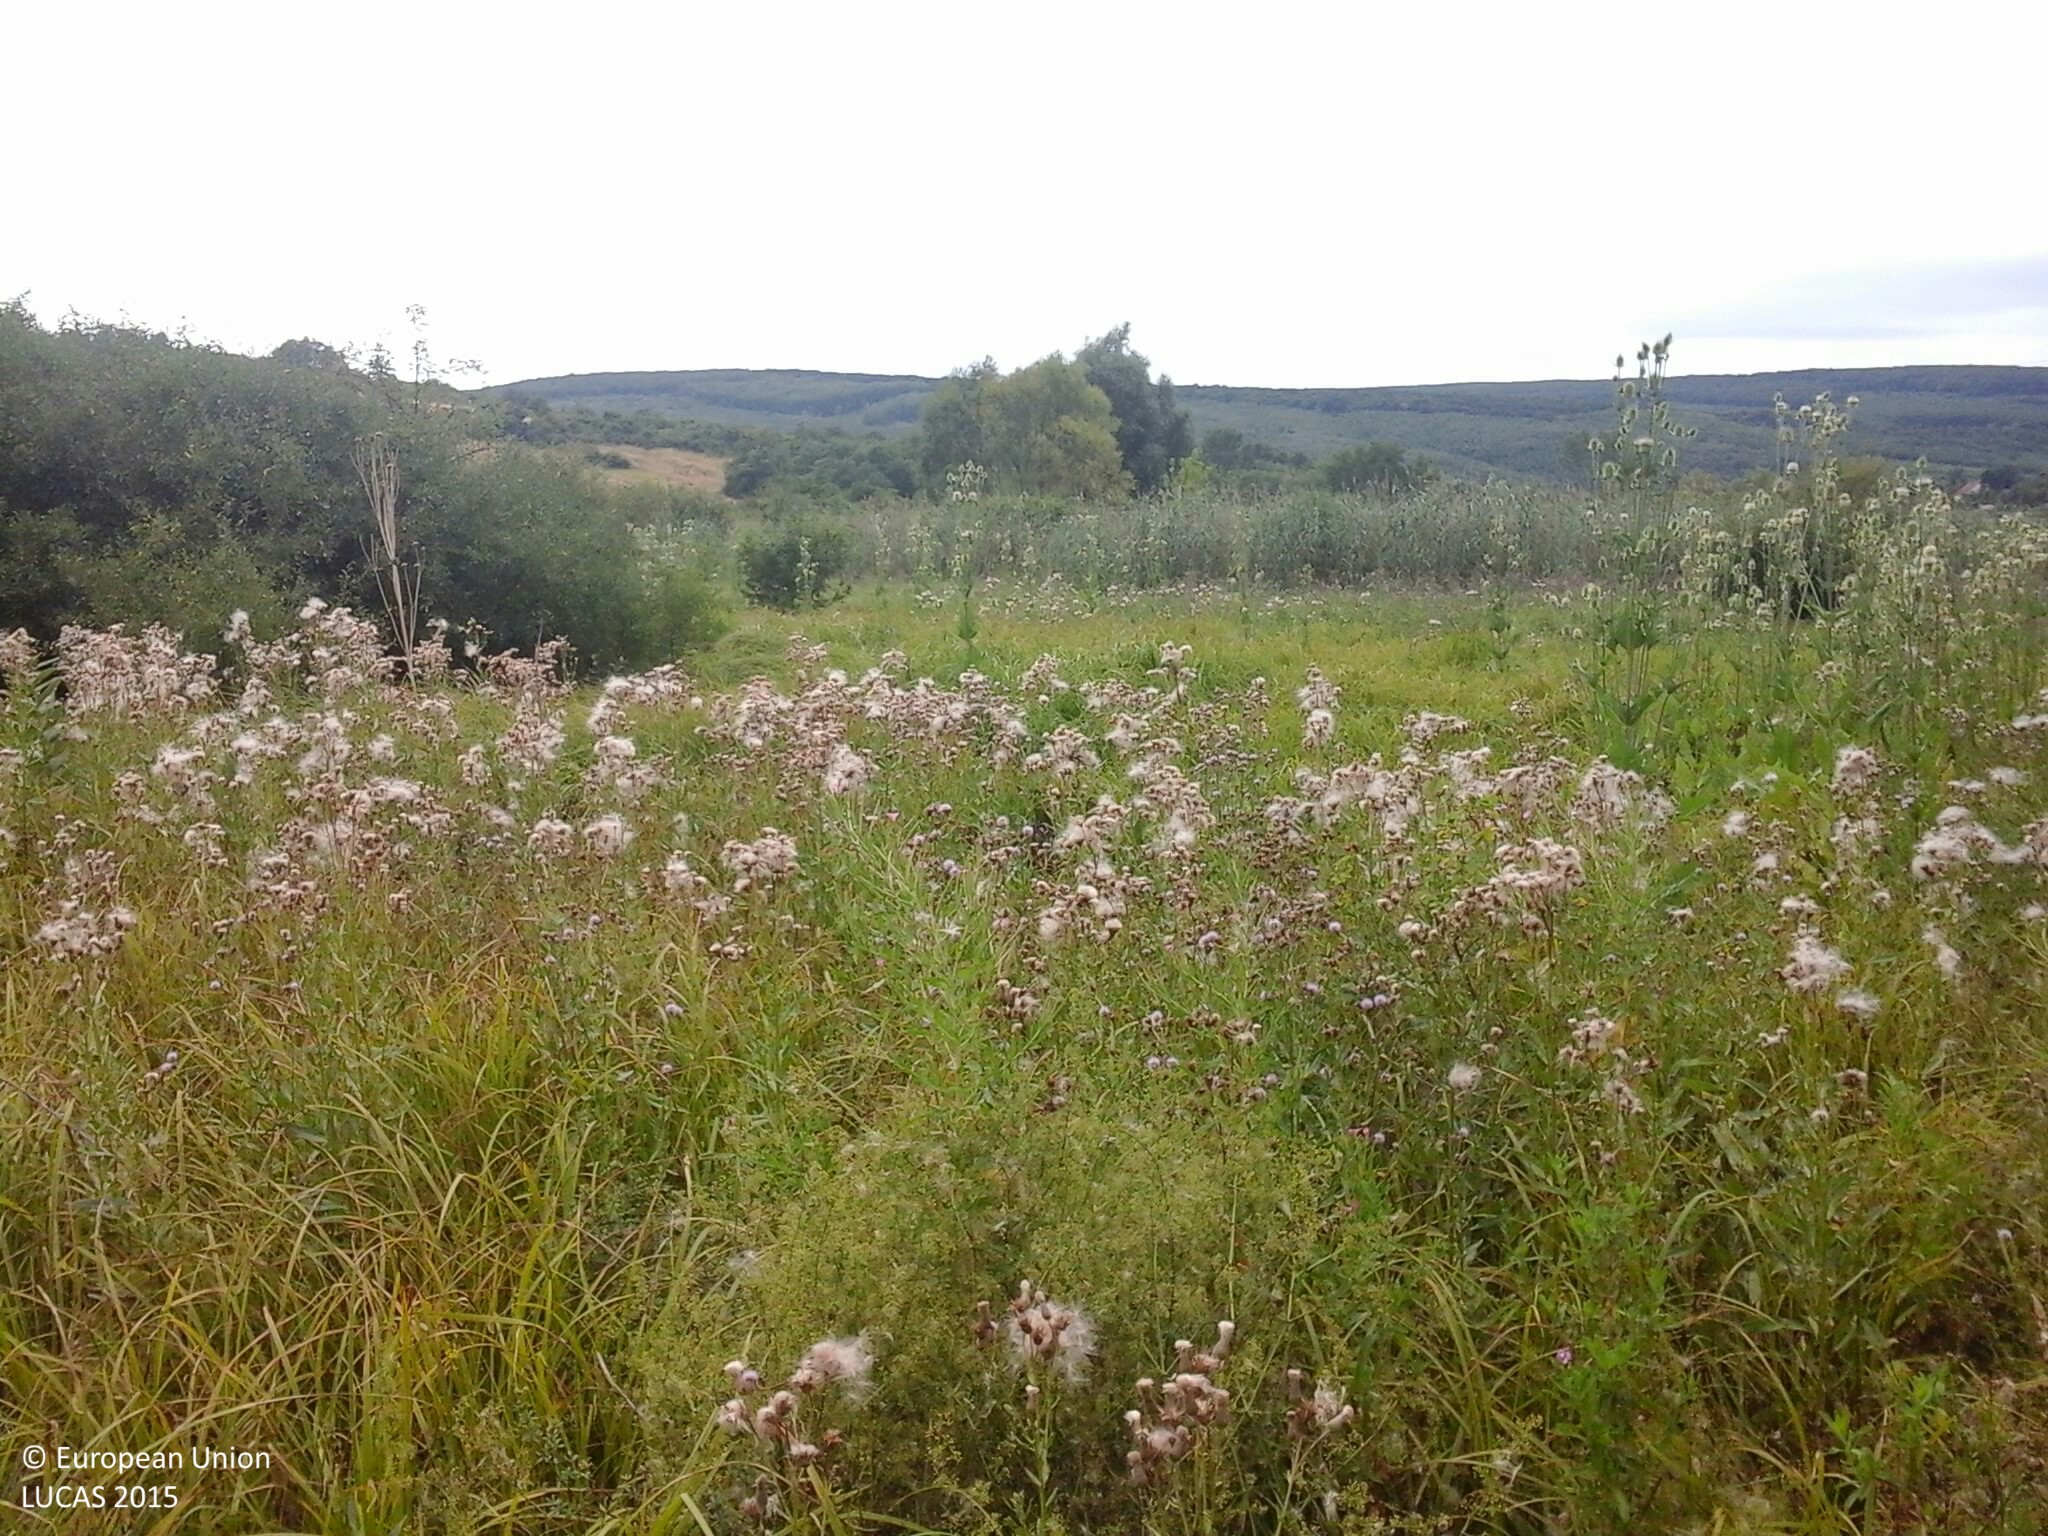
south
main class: Grassland
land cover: Grassland with sparse tree/shrub cover
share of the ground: > 75 %
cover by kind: herbaceous plants 95 %, broadleaved forest trees 5 %
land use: Semi-natural and natural areas not in use
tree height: < 5 m
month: July
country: HU
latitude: 47.9229
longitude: 19.2685
